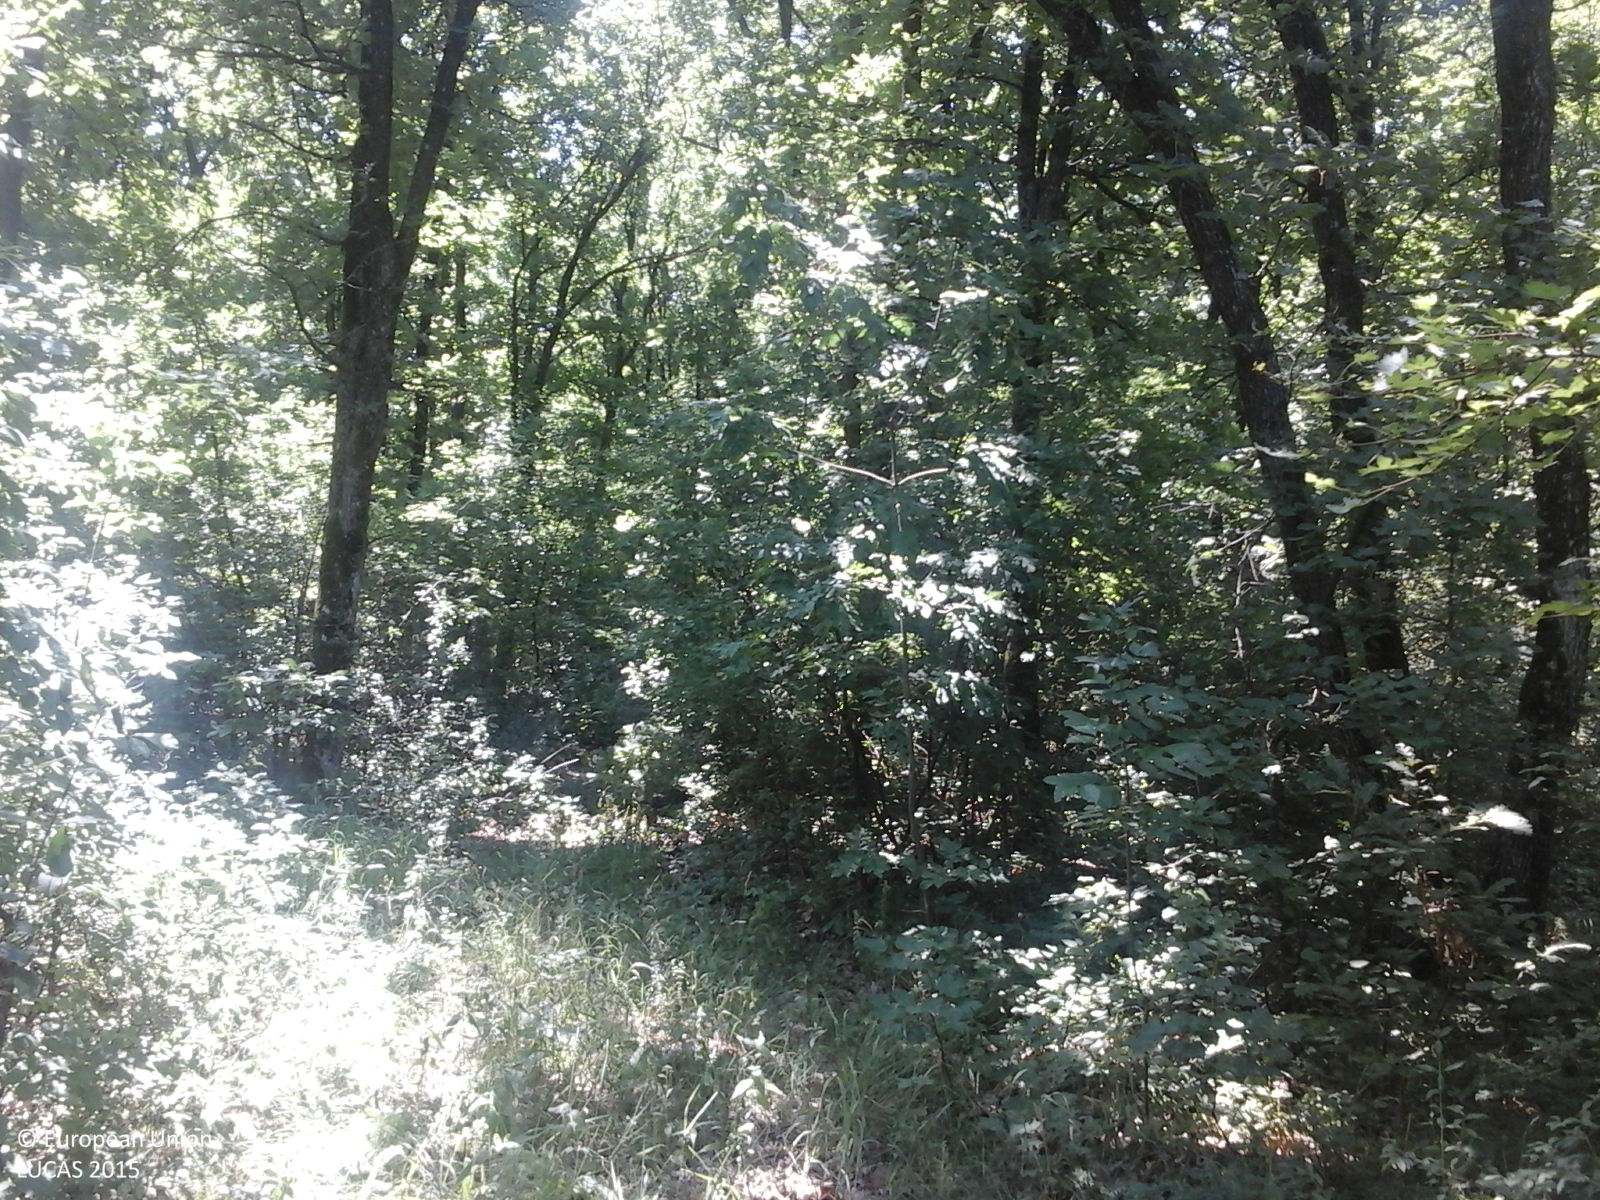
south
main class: Woodland
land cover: Broadleaved woodland
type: acidophilous oak and oak-birch forest
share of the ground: > 75 %
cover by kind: broadleaved forest trees 100 %
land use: Forestry
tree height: > 5 m
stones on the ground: < 10 %
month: July
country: RO
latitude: 44.6630
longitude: 24.3594
